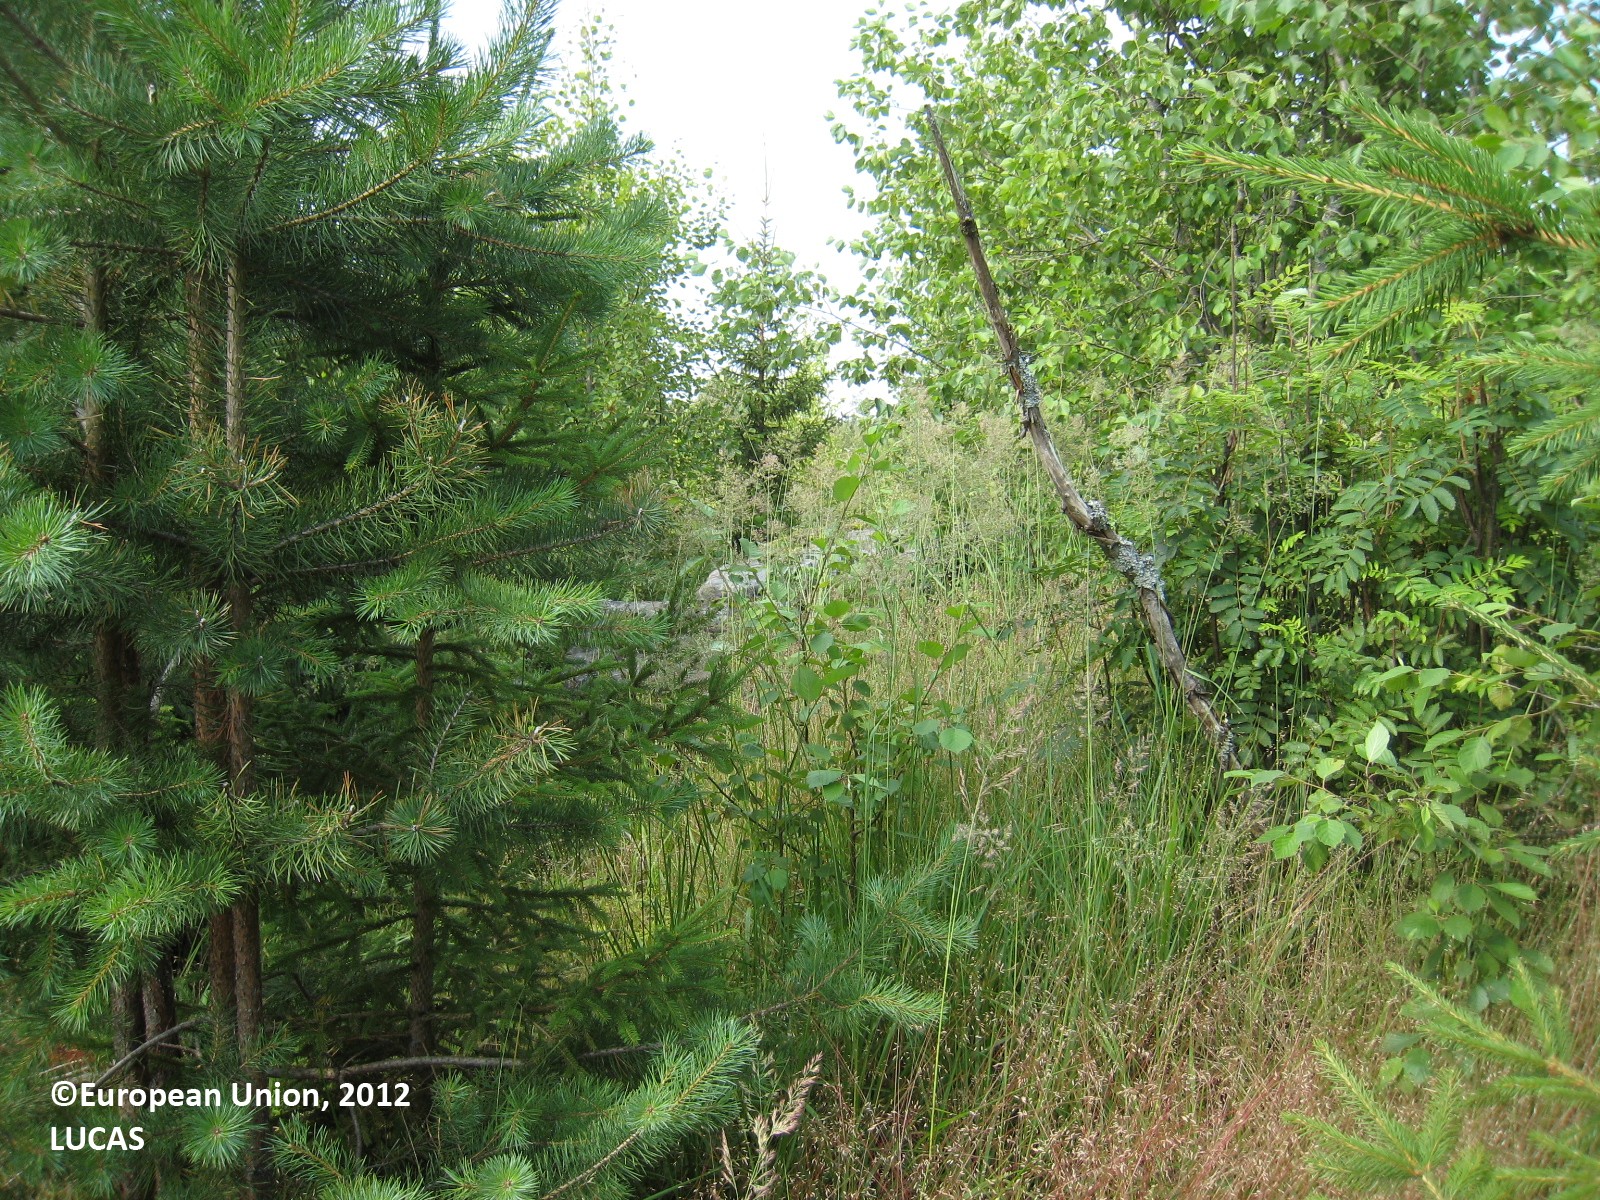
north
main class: Woodland
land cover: Other mixed woodland
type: boreal forest
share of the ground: 50 - 75 %
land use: Forestry
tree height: < 5 m
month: July
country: FI
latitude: 62.4066
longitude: 27.3682
